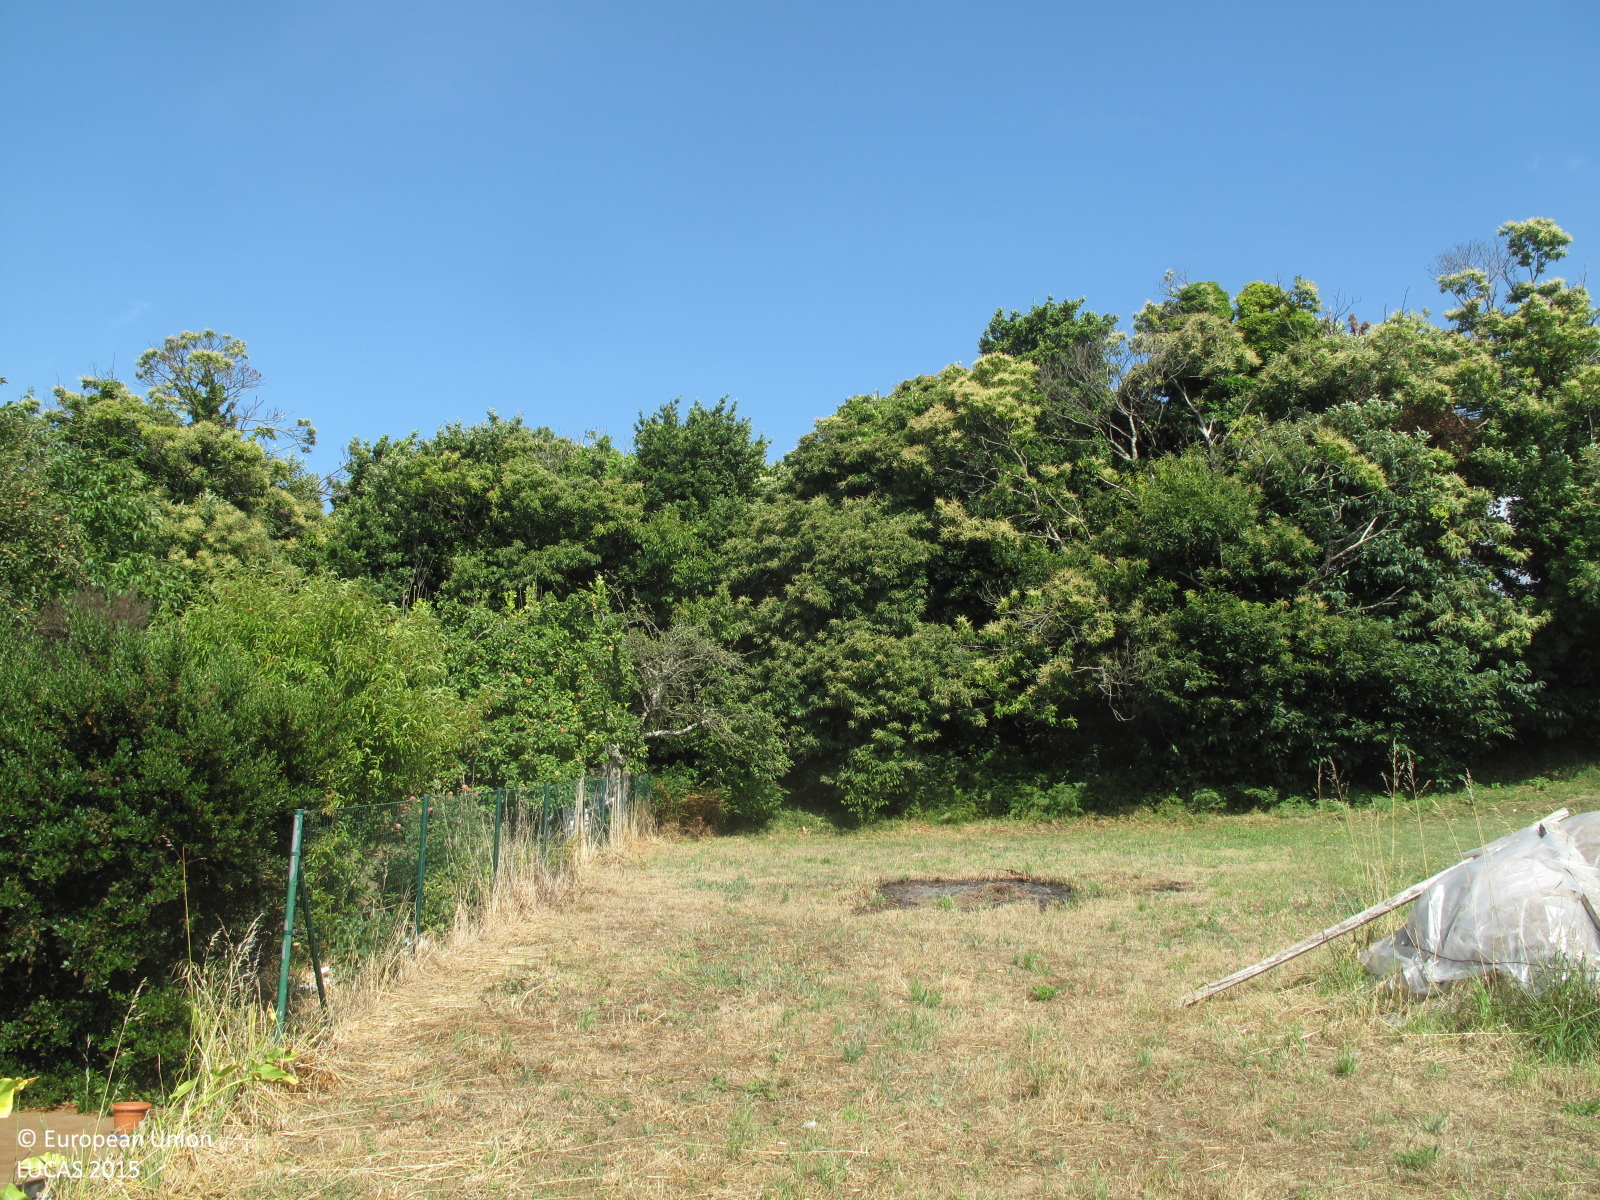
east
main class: Grassland
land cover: Grassland without tree/shrub cover
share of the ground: > 75 %
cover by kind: herbaceous plants 90 %, shrubs 5 %, unconsolidated bare surface 5 %
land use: Agriculture (excluding fallow land and kitchen gardens)
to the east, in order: Grassland without tree/shrub cover; Broadleaved woodland; Tracks; Other mixed woodland; Tracks; Broadleaved woodland; Paved roads, cycling and walking lanes; Dry stone walls; Grassland with sparse tree/shrub cover; Dry stone walls; Broadleaved woodland
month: July
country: ES
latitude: 43.4653
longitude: -8.1845
